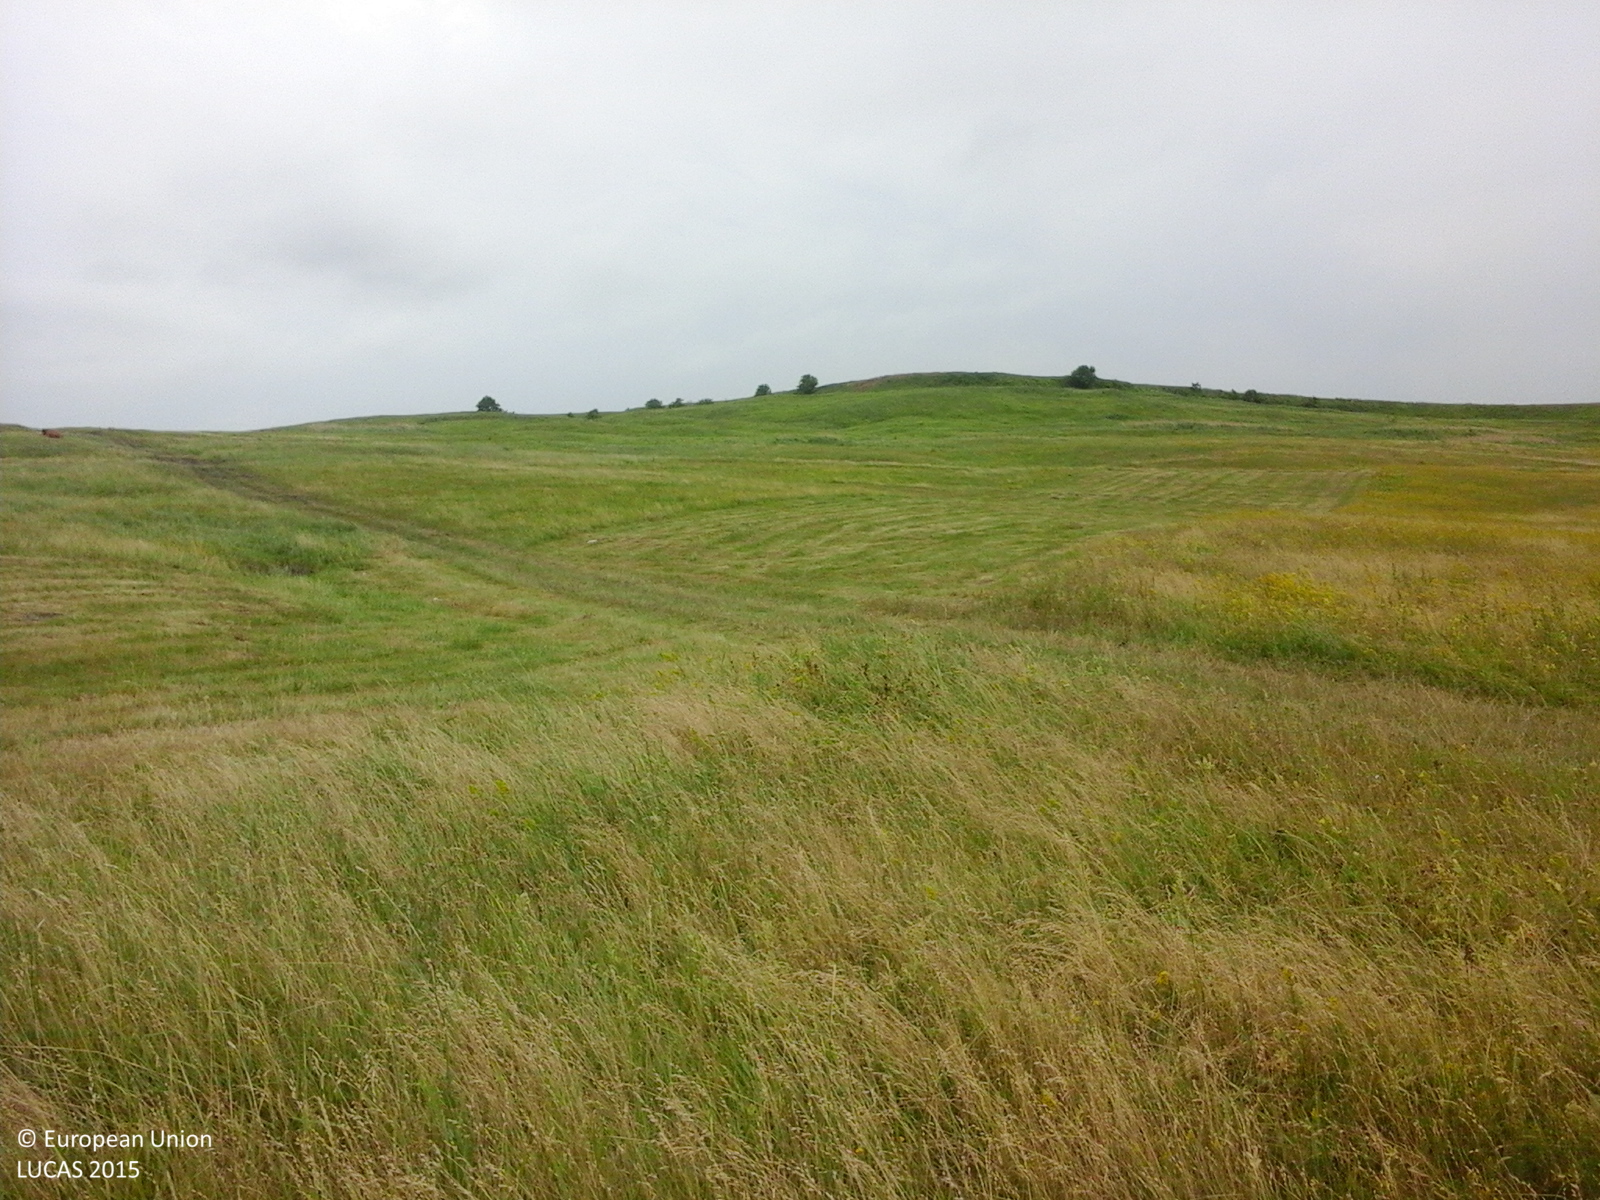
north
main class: Grassland
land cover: Grassland without tree/shrub cover
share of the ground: > 75 %
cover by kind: herbaceous plants 100 %
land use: Agriculture (excluding fallow land and kitchen gardens)
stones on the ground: < 10 %
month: June
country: RO
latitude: 47.8319
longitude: 26.6199
